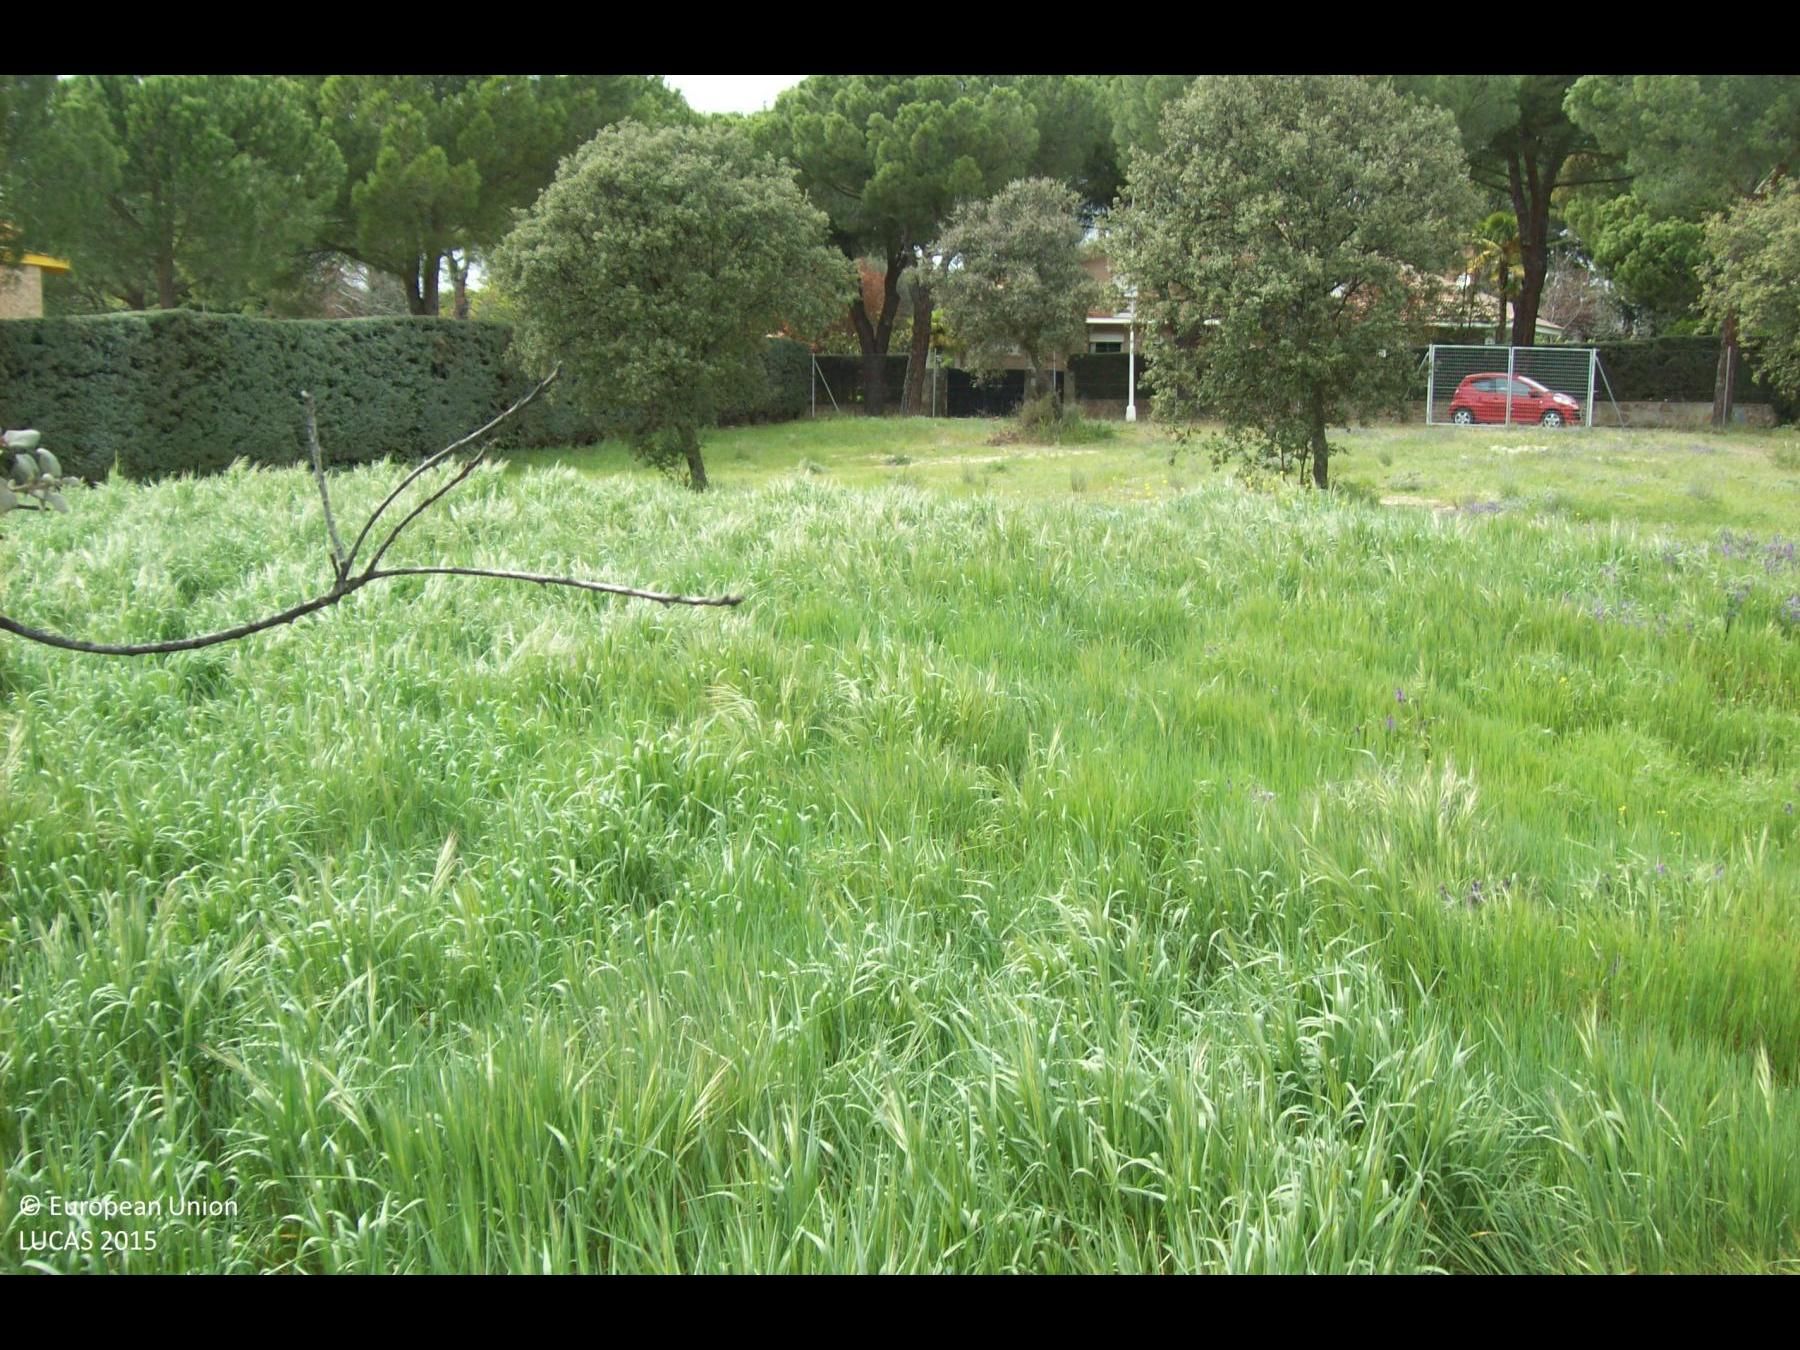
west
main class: Grassland
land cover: Grassland with sparse tree/shrub cover
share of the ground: > 75 %
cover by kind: herbaceous plants 95 %, broadleaved forest trees 5 %
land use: Semi-natural and natural areas not in use
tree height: < 5 m
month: April
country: ES
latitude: 40.4284
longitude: -3.8903
